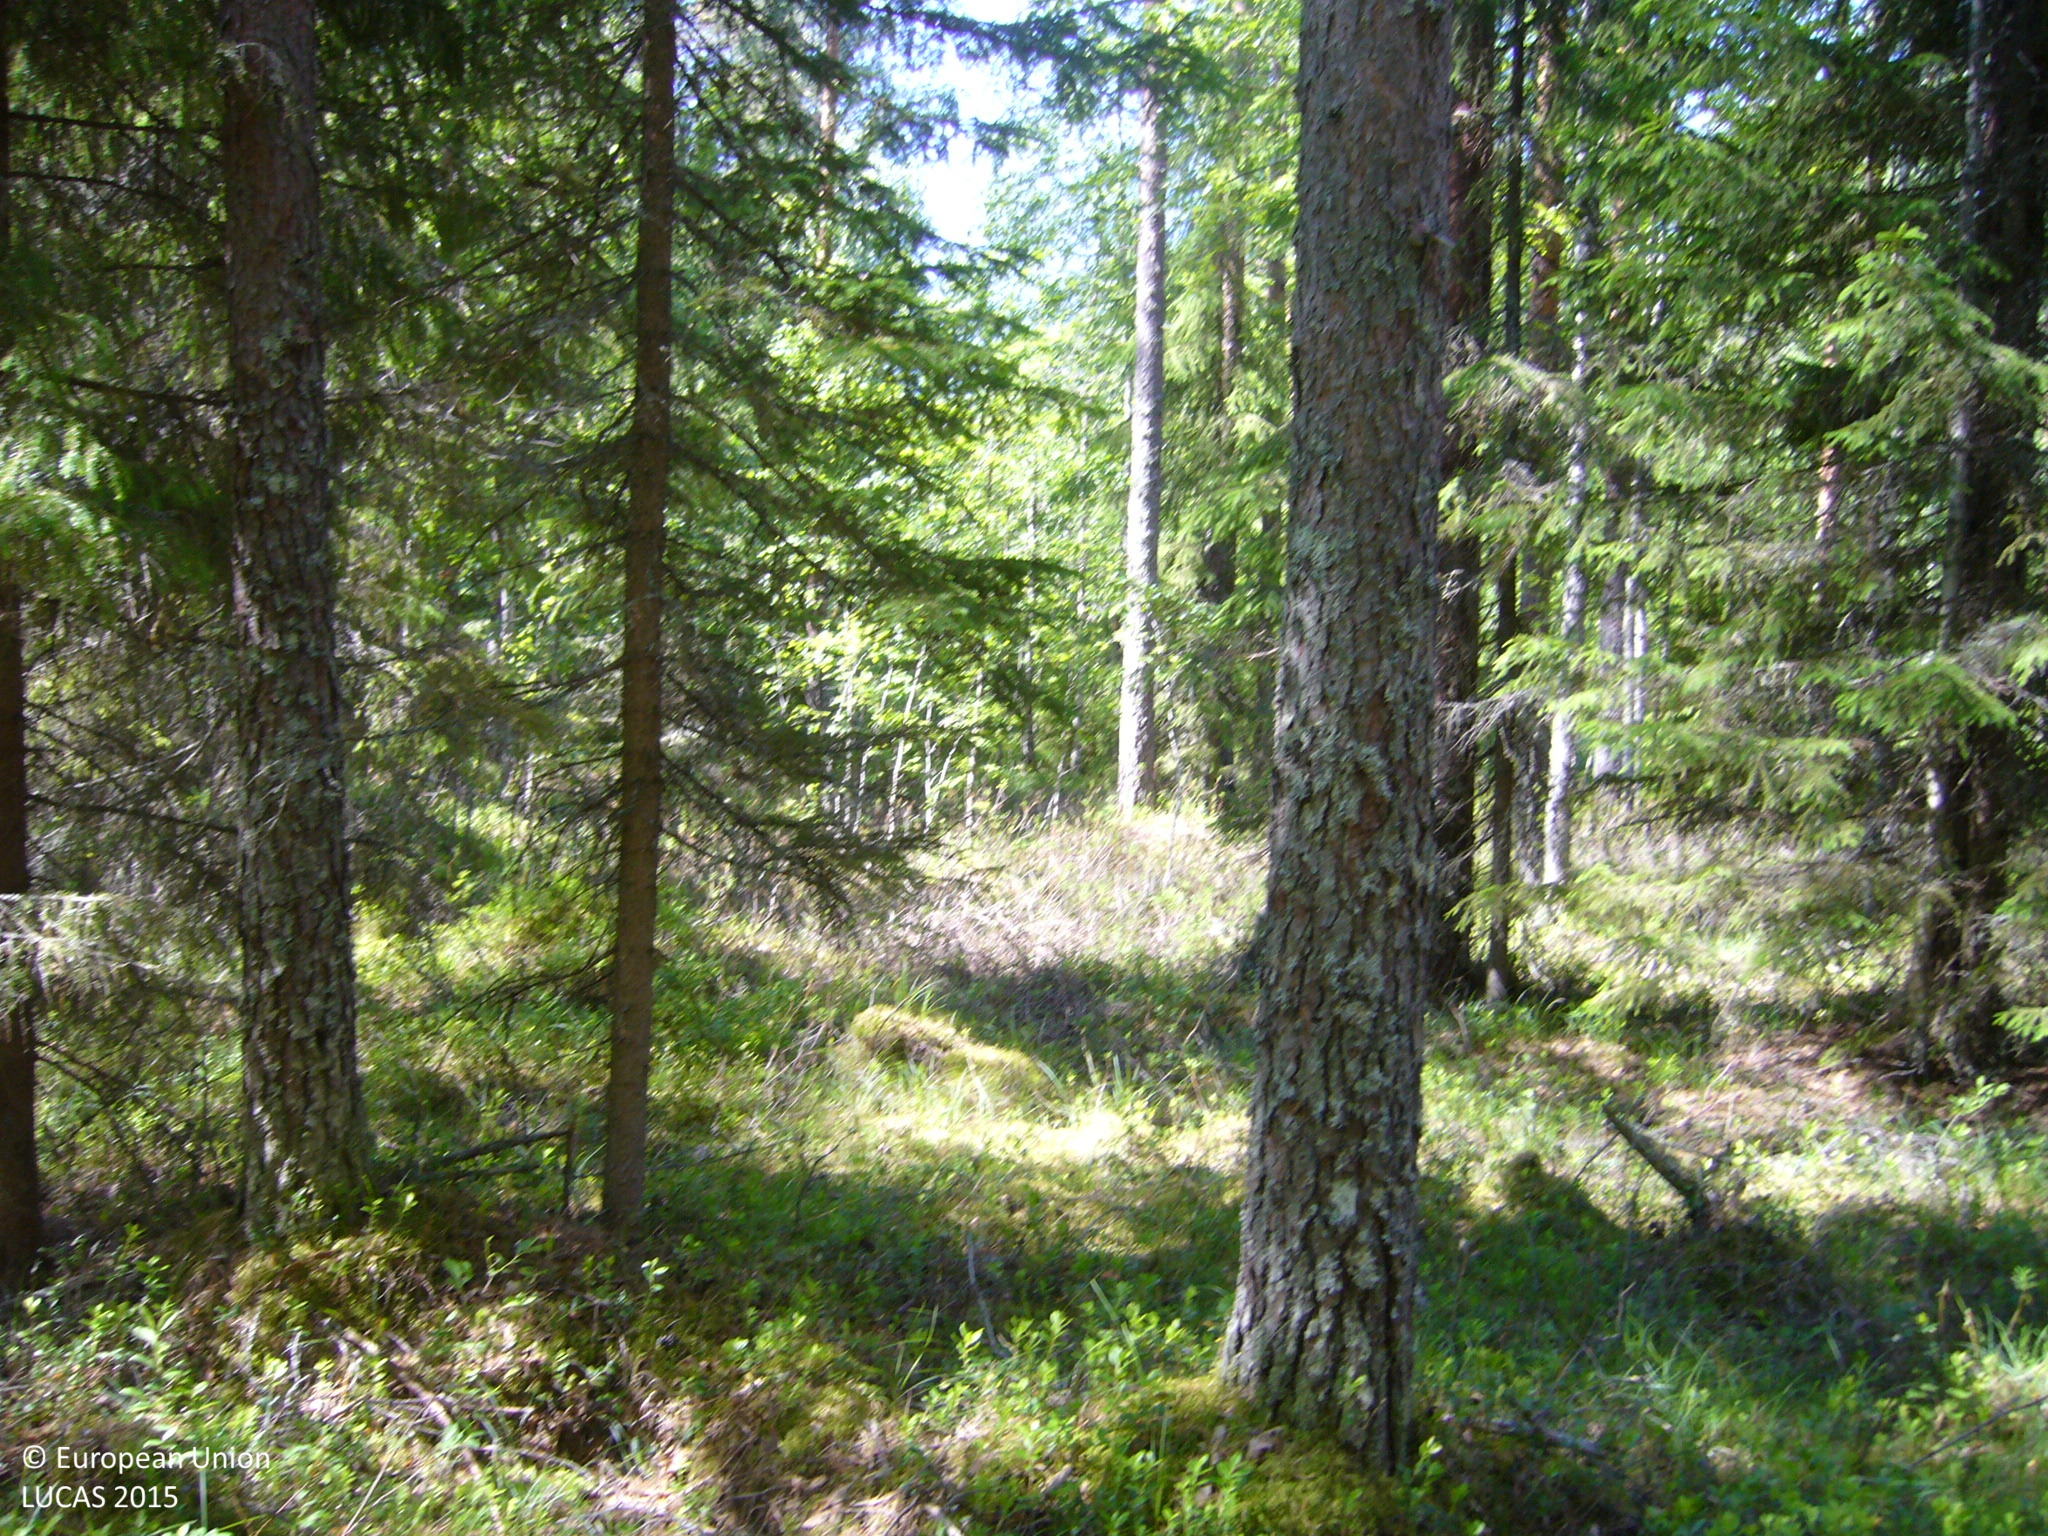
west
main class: Woodland
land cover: Pine dominated coniferous woodland
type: boreal forest
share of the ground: > 75 %
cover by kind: coniferous forest trees 60 %, shrubs 25 %, broadleaved forest trees 15 %
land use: Forestry
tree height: > 5 m
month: July
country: FI
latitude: 63.3895
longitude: 25.8596
